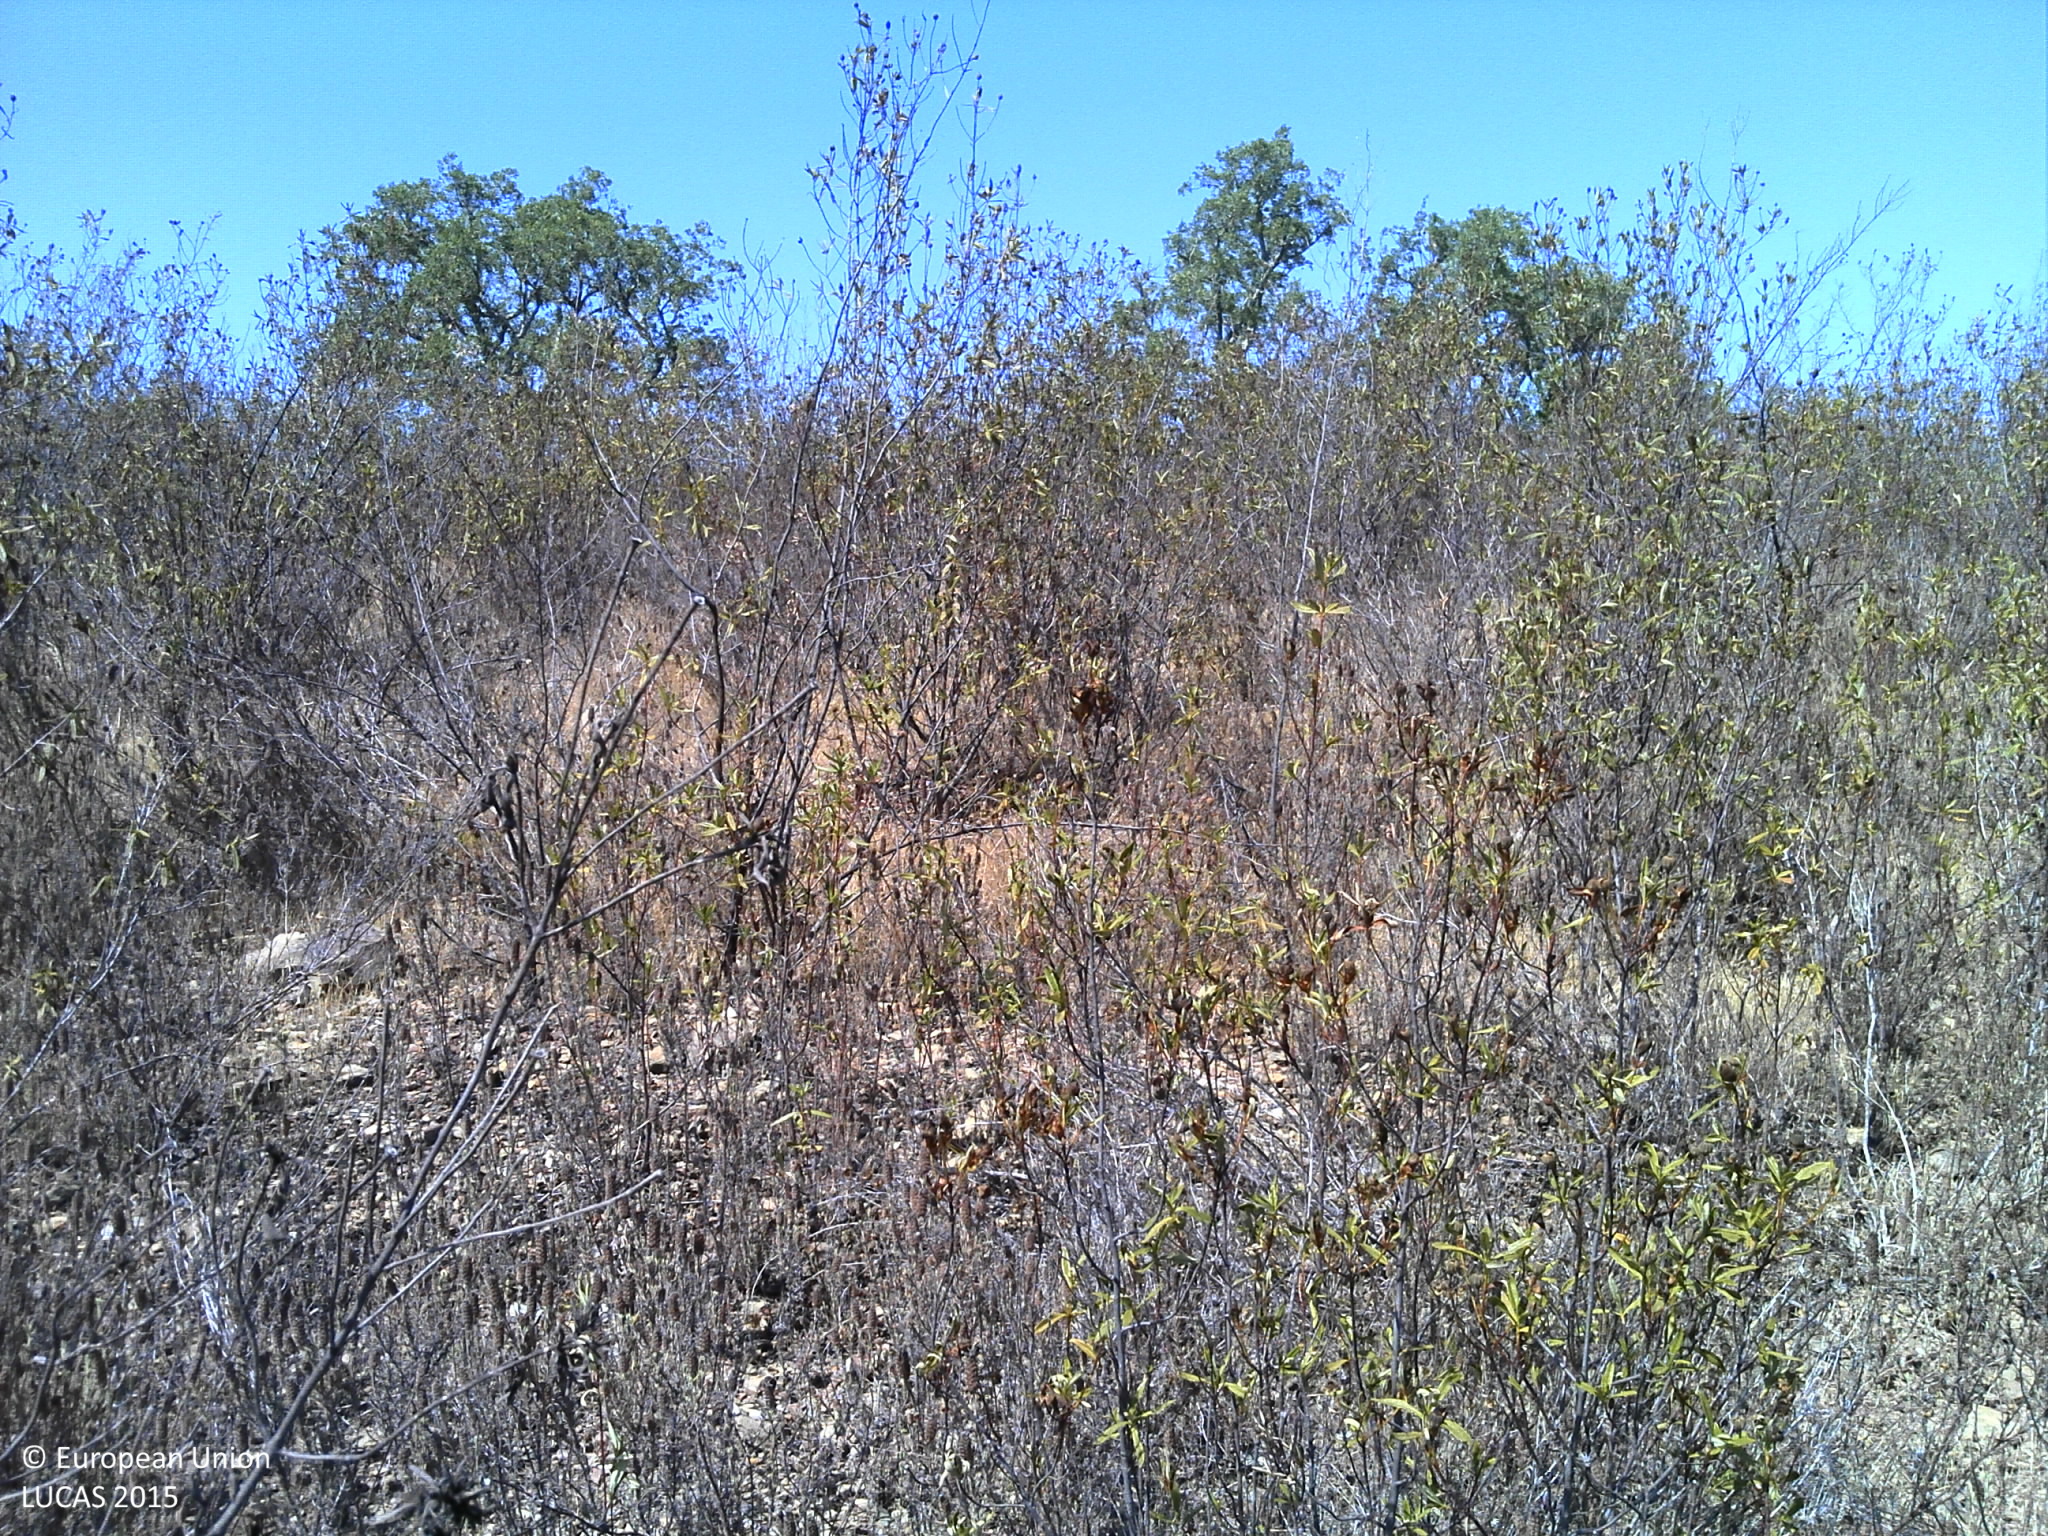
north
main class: Shrubland
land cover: Shrubland without tree cover
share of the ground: 50 - 75 %
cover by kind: shrubs 75 %, unconsolidated bare surface 20 %, herbaceous plants 5 %
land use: Forestry
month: September
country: PT
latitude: 37.4676
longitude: -8.2404
